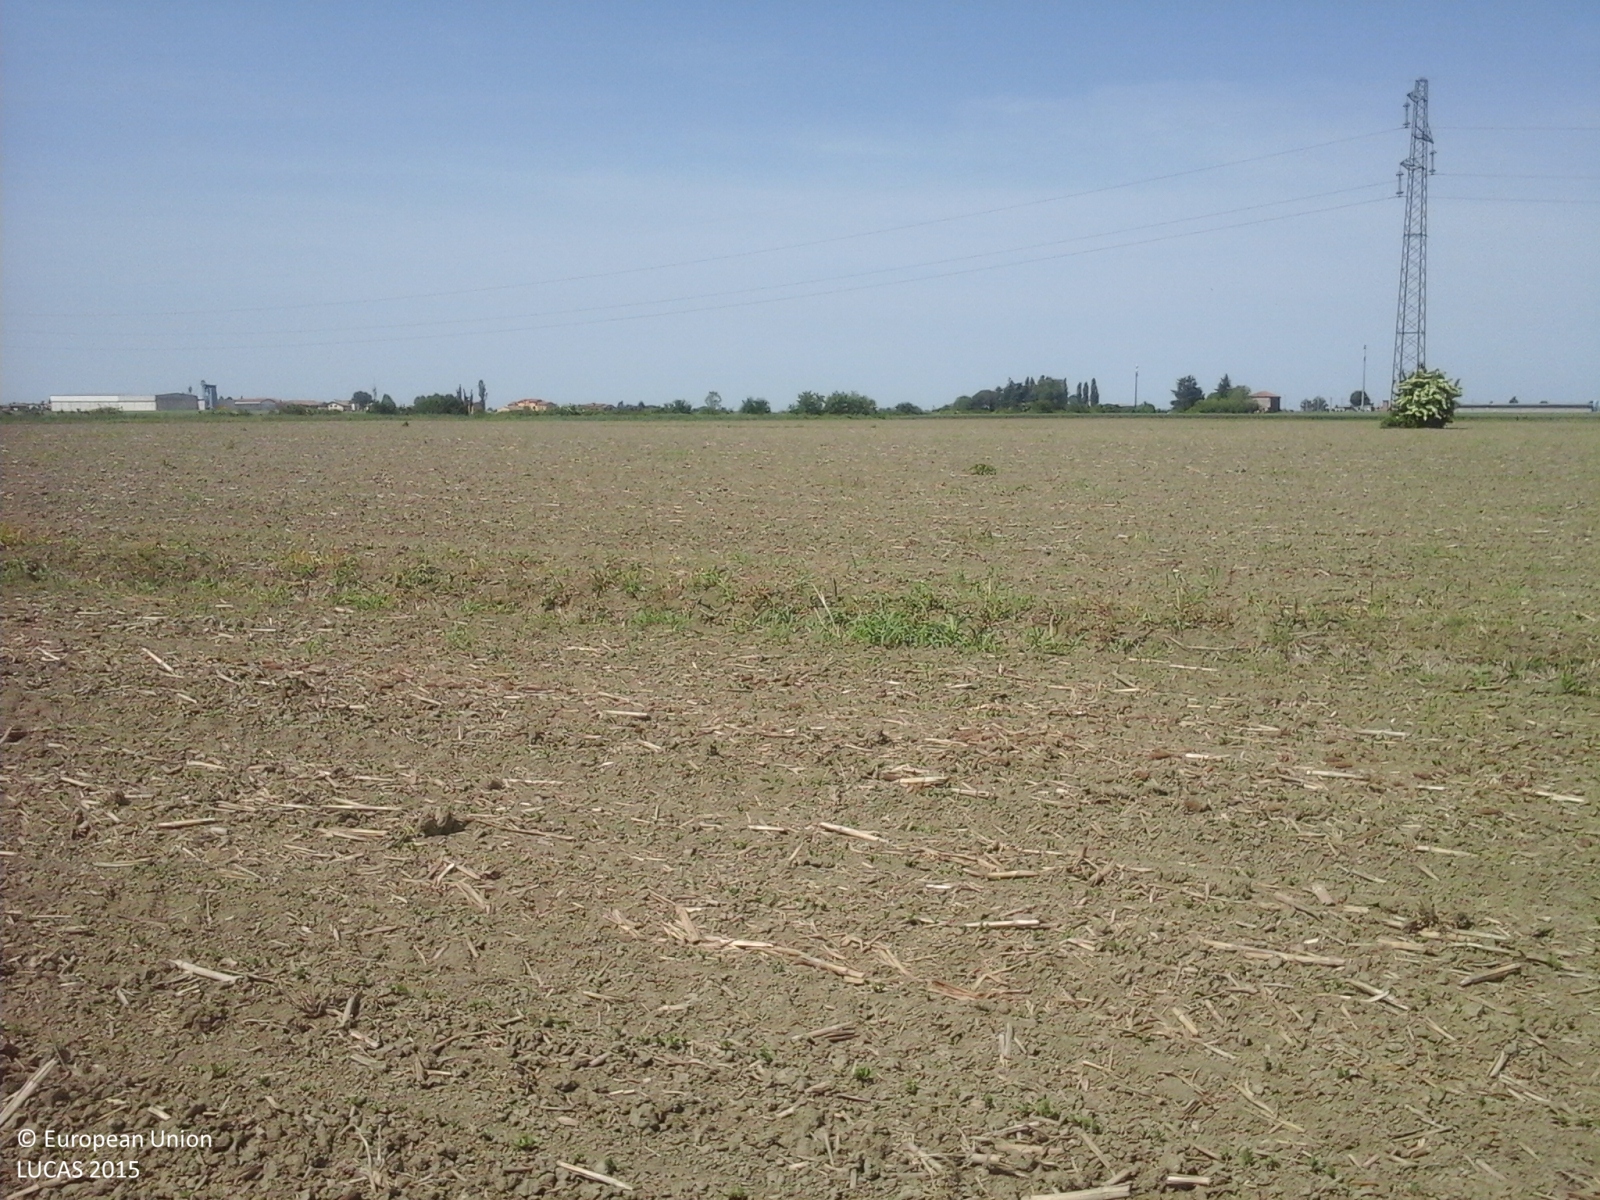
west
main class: Cropland
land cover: Soya
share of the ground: < 10 %
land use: Agriculture (excluding fallow land and kitchen gardens)
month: May
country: IT
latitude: 44.9858
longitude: 11.7089
